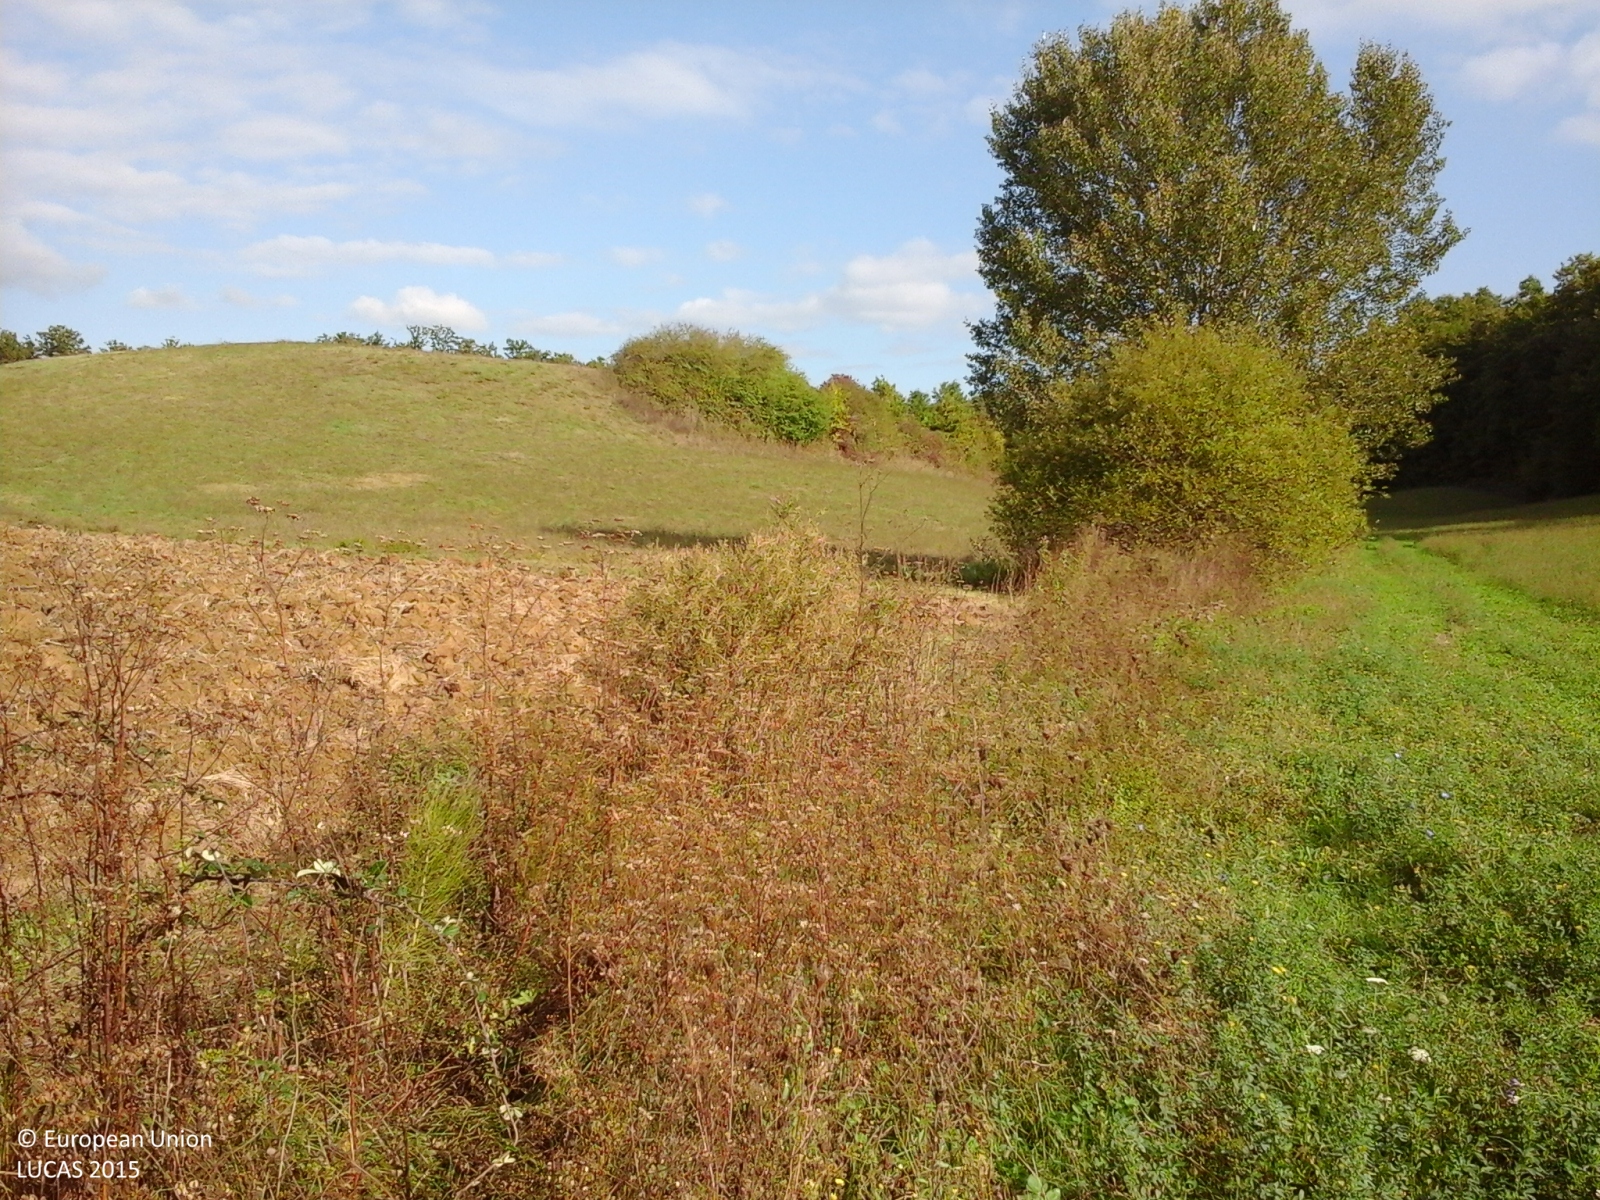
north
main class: Cropland
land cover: Lucerne
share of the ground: > 75 %
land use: Agriculture (excluding fallow land and kitchen gardens)
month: October
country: IT
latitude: 43.2880
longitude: 12.6425
